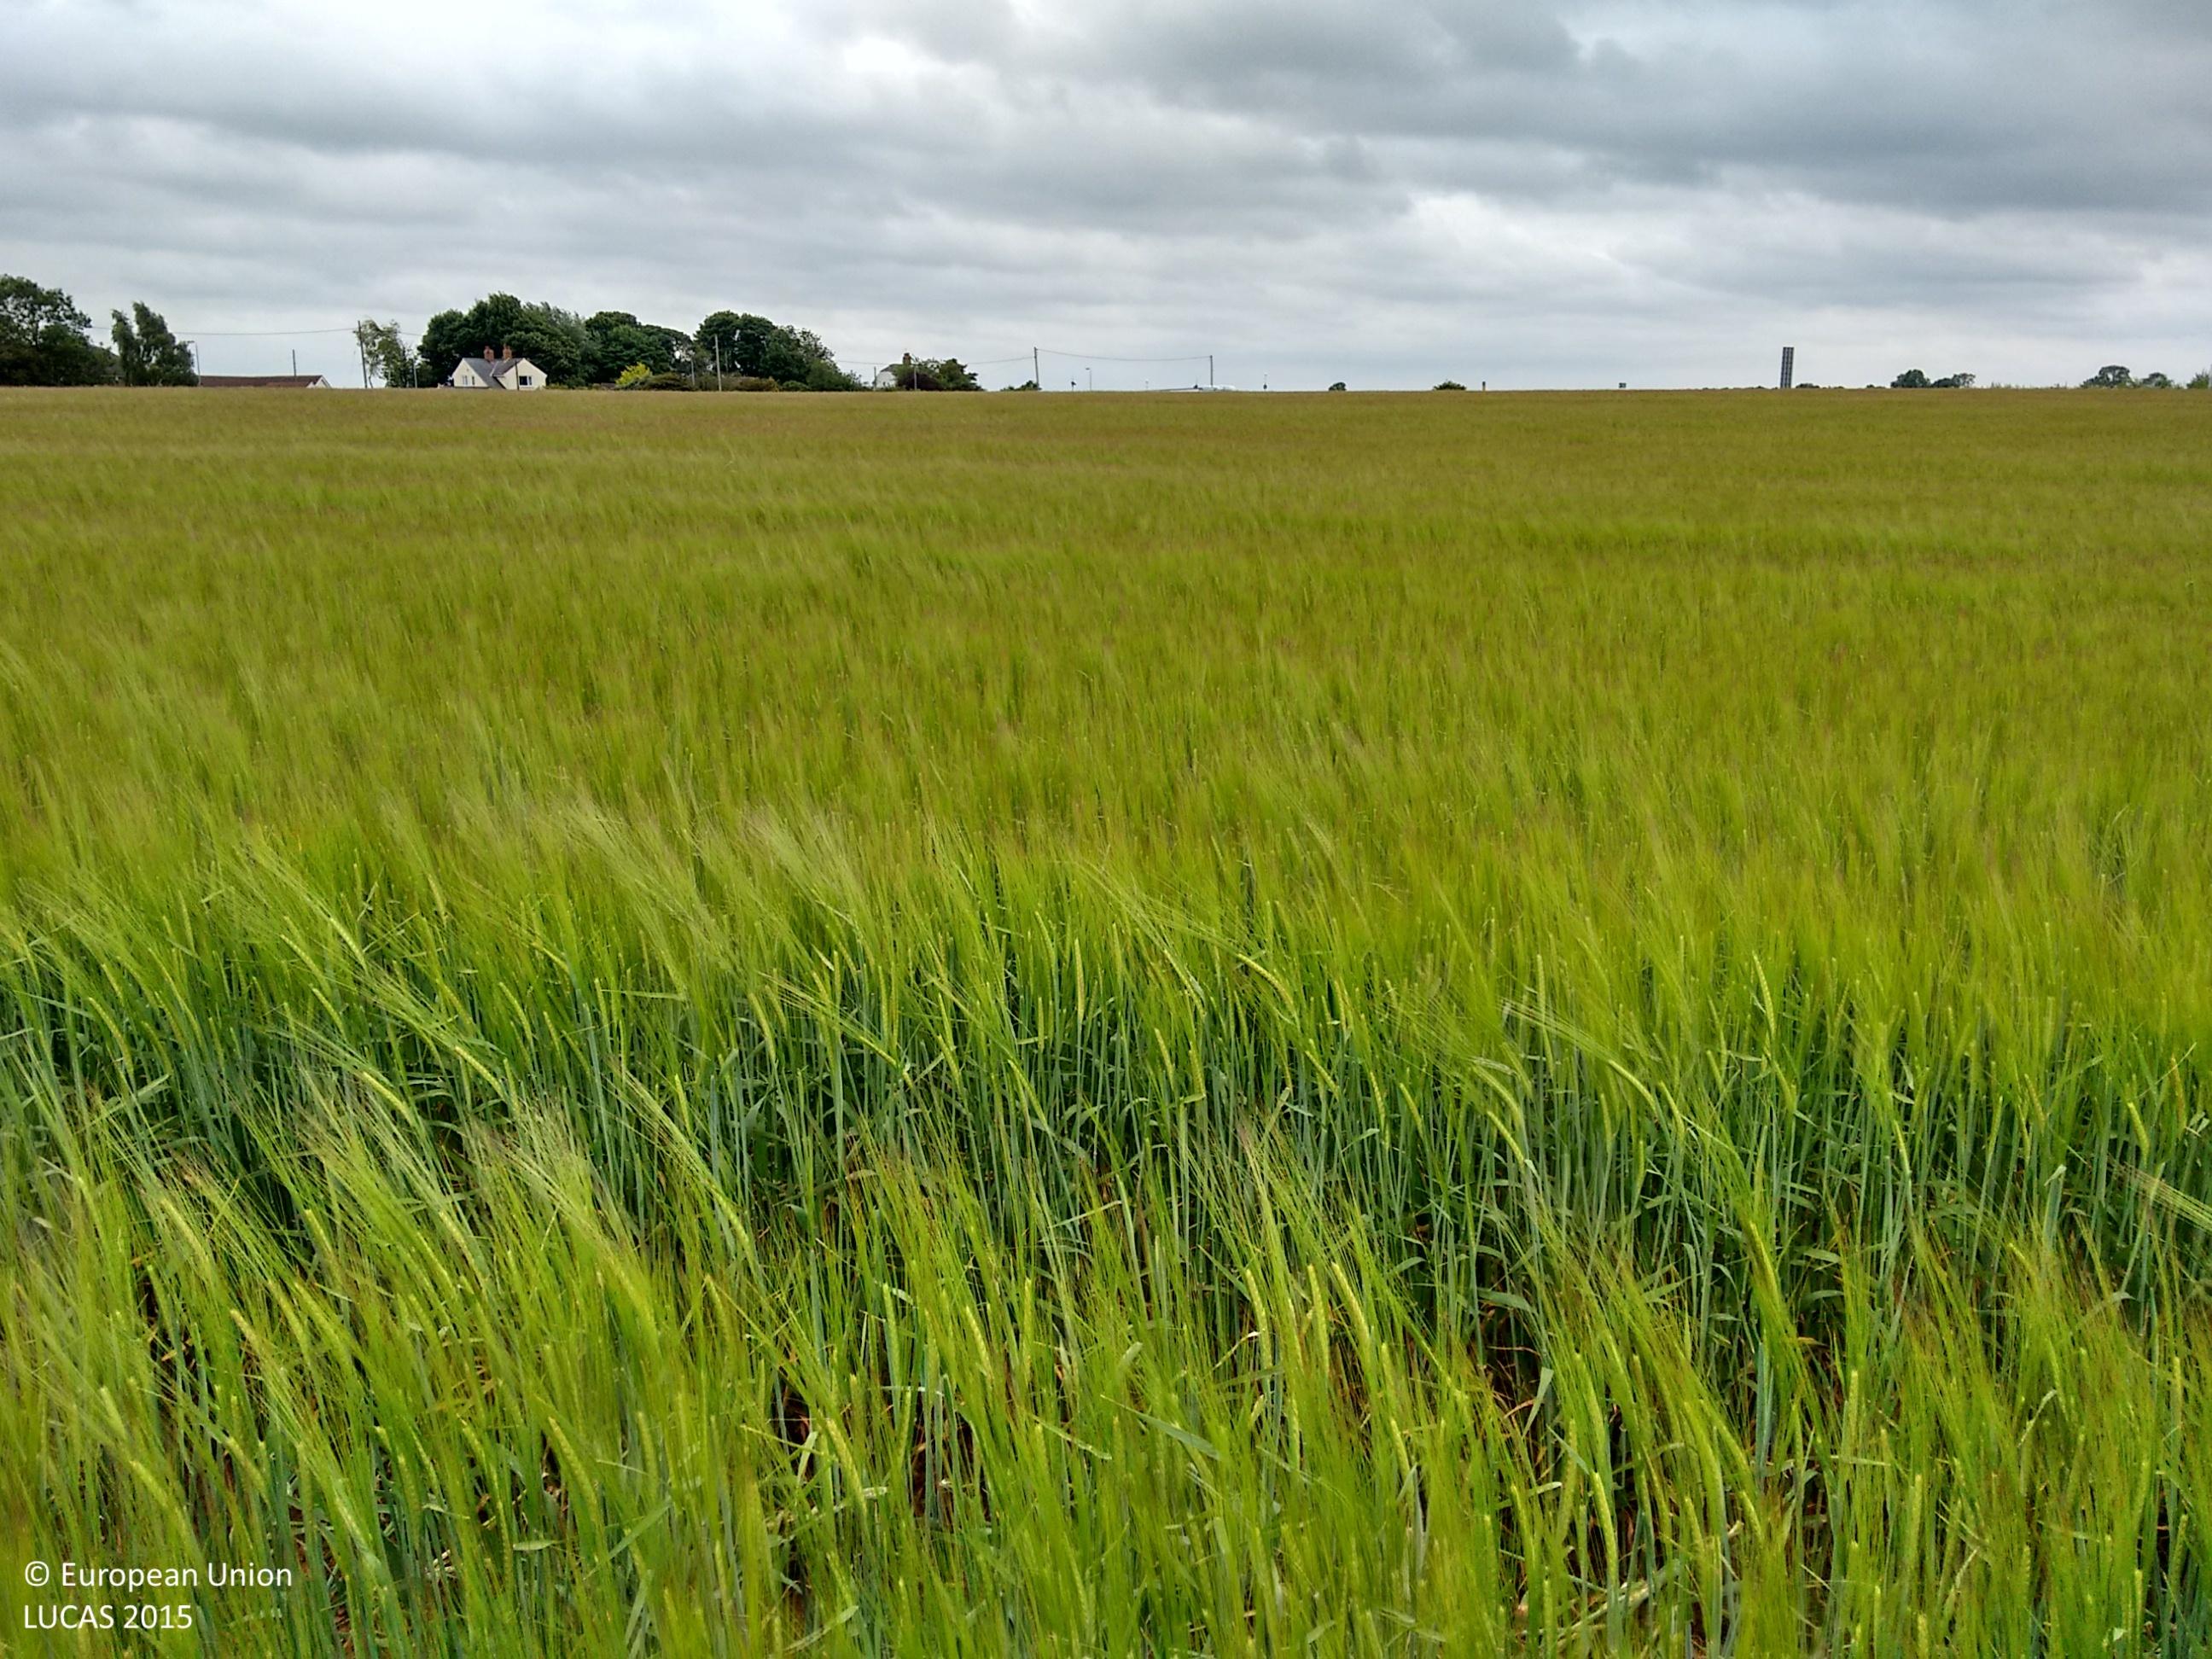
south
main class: Cropland
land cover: Barley
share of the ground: > 75 %
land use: Agriculture (excluding fallow land and kitchen gardens)
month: June
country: GB
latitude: 53.0330
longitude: -0.5211
